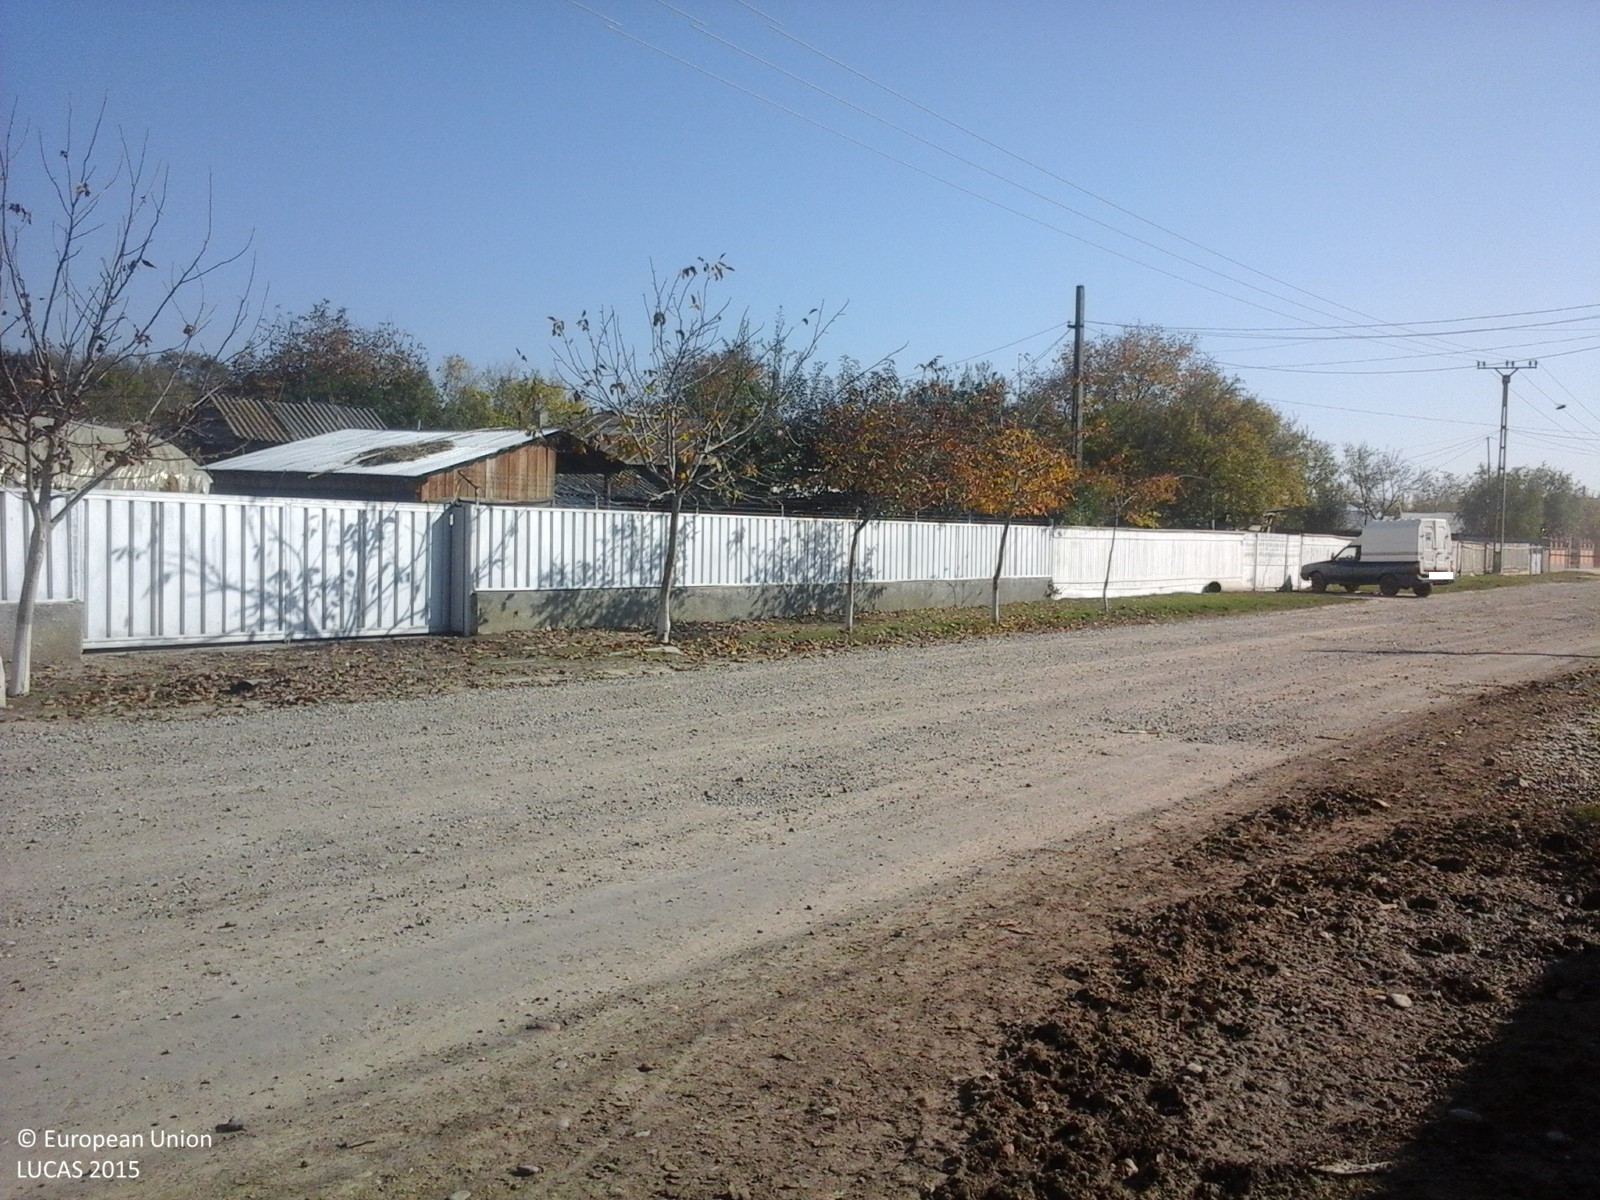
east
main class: Cropland
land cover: Maize
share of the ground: 25 - 50 %
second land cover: Spontaneously vegetated surfaces
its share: 25 - 50 %
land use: Kitchen garden
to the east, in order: Maize; Spontaneously vegetated surfaces; Artificial constructions in urban areas; Spontaneously vegetated surfaces; Abandoned hedges; Fences; Spontaneously vegetated surfaces; Fences; Abandoned hedges; Spontaneously vegetated surfaces; Broadleaved woodland; Spontaneously vegetated surfaces
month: October
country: RO
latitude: 45.6673
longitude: 27.3903
